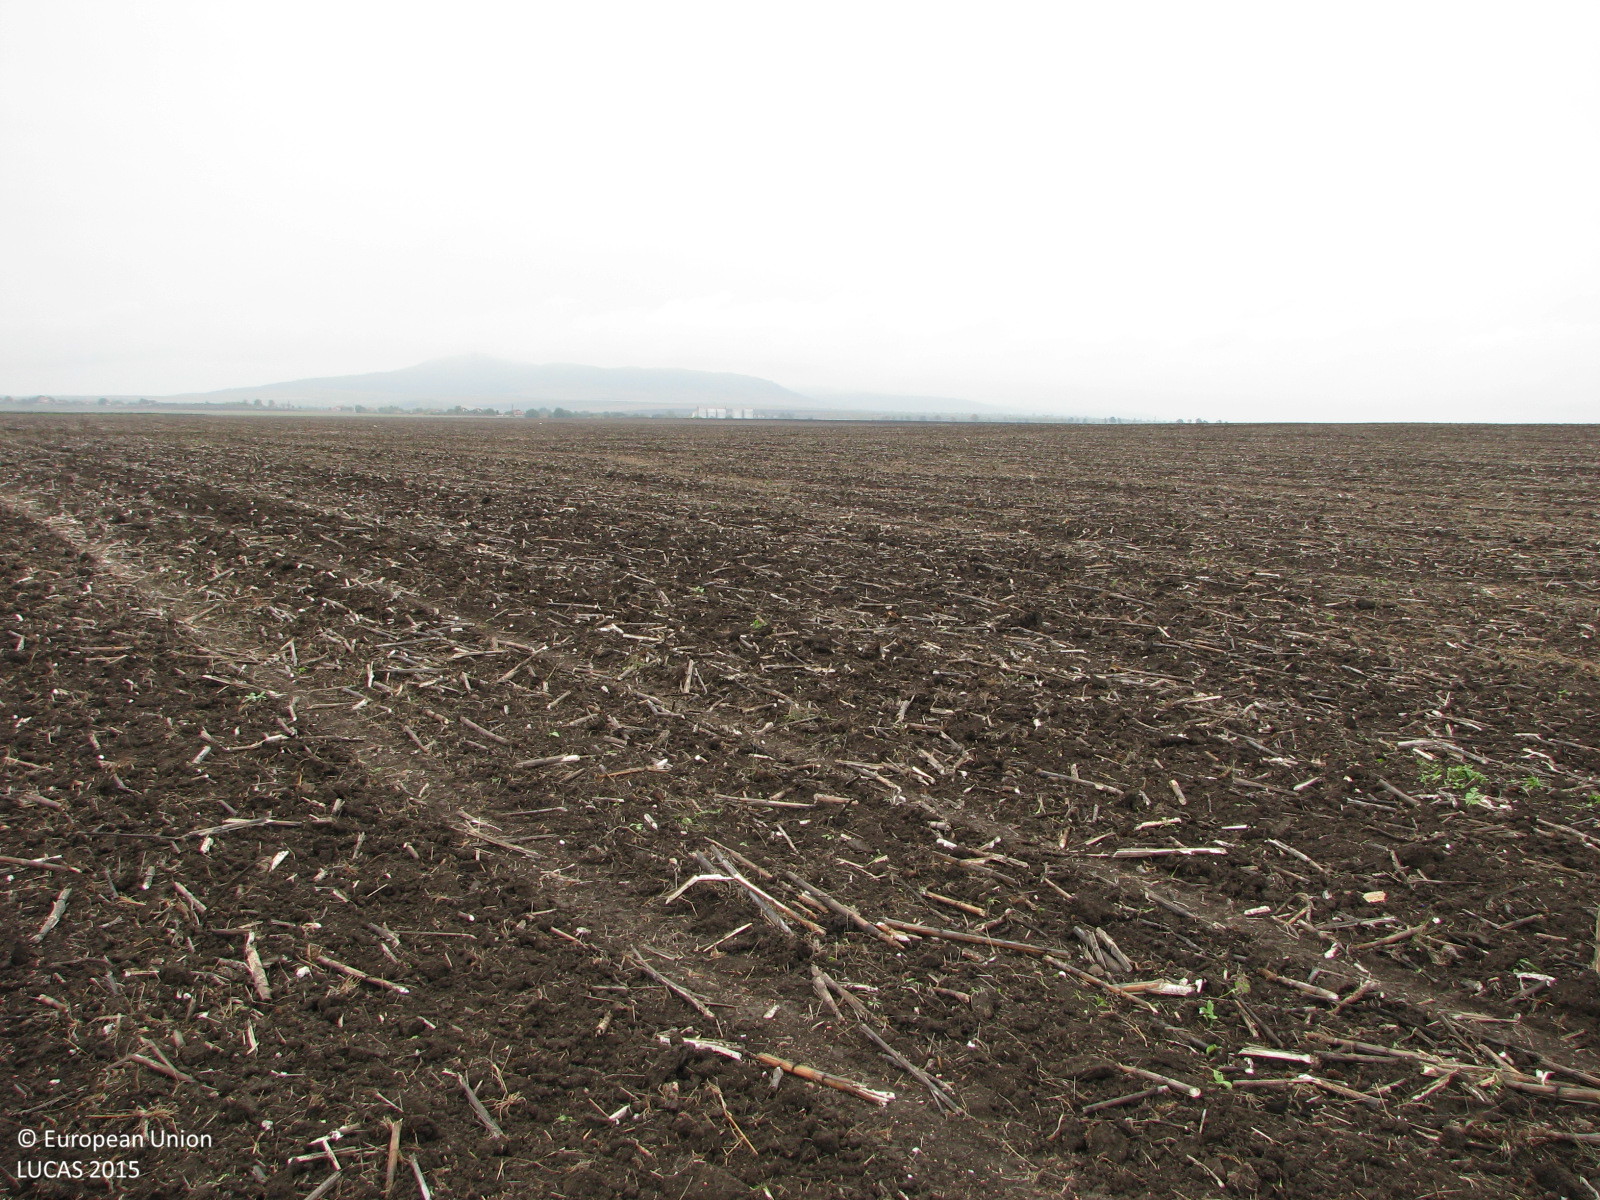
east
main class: Cropland
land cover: Sunflower
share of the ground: < 10 %
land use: Agriculture (excluding fallow land and kitchen gardens)
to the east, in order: Sunflower; Tracks; Sunflower
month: October
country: BG
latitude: 42.4163
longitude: 26.5839
